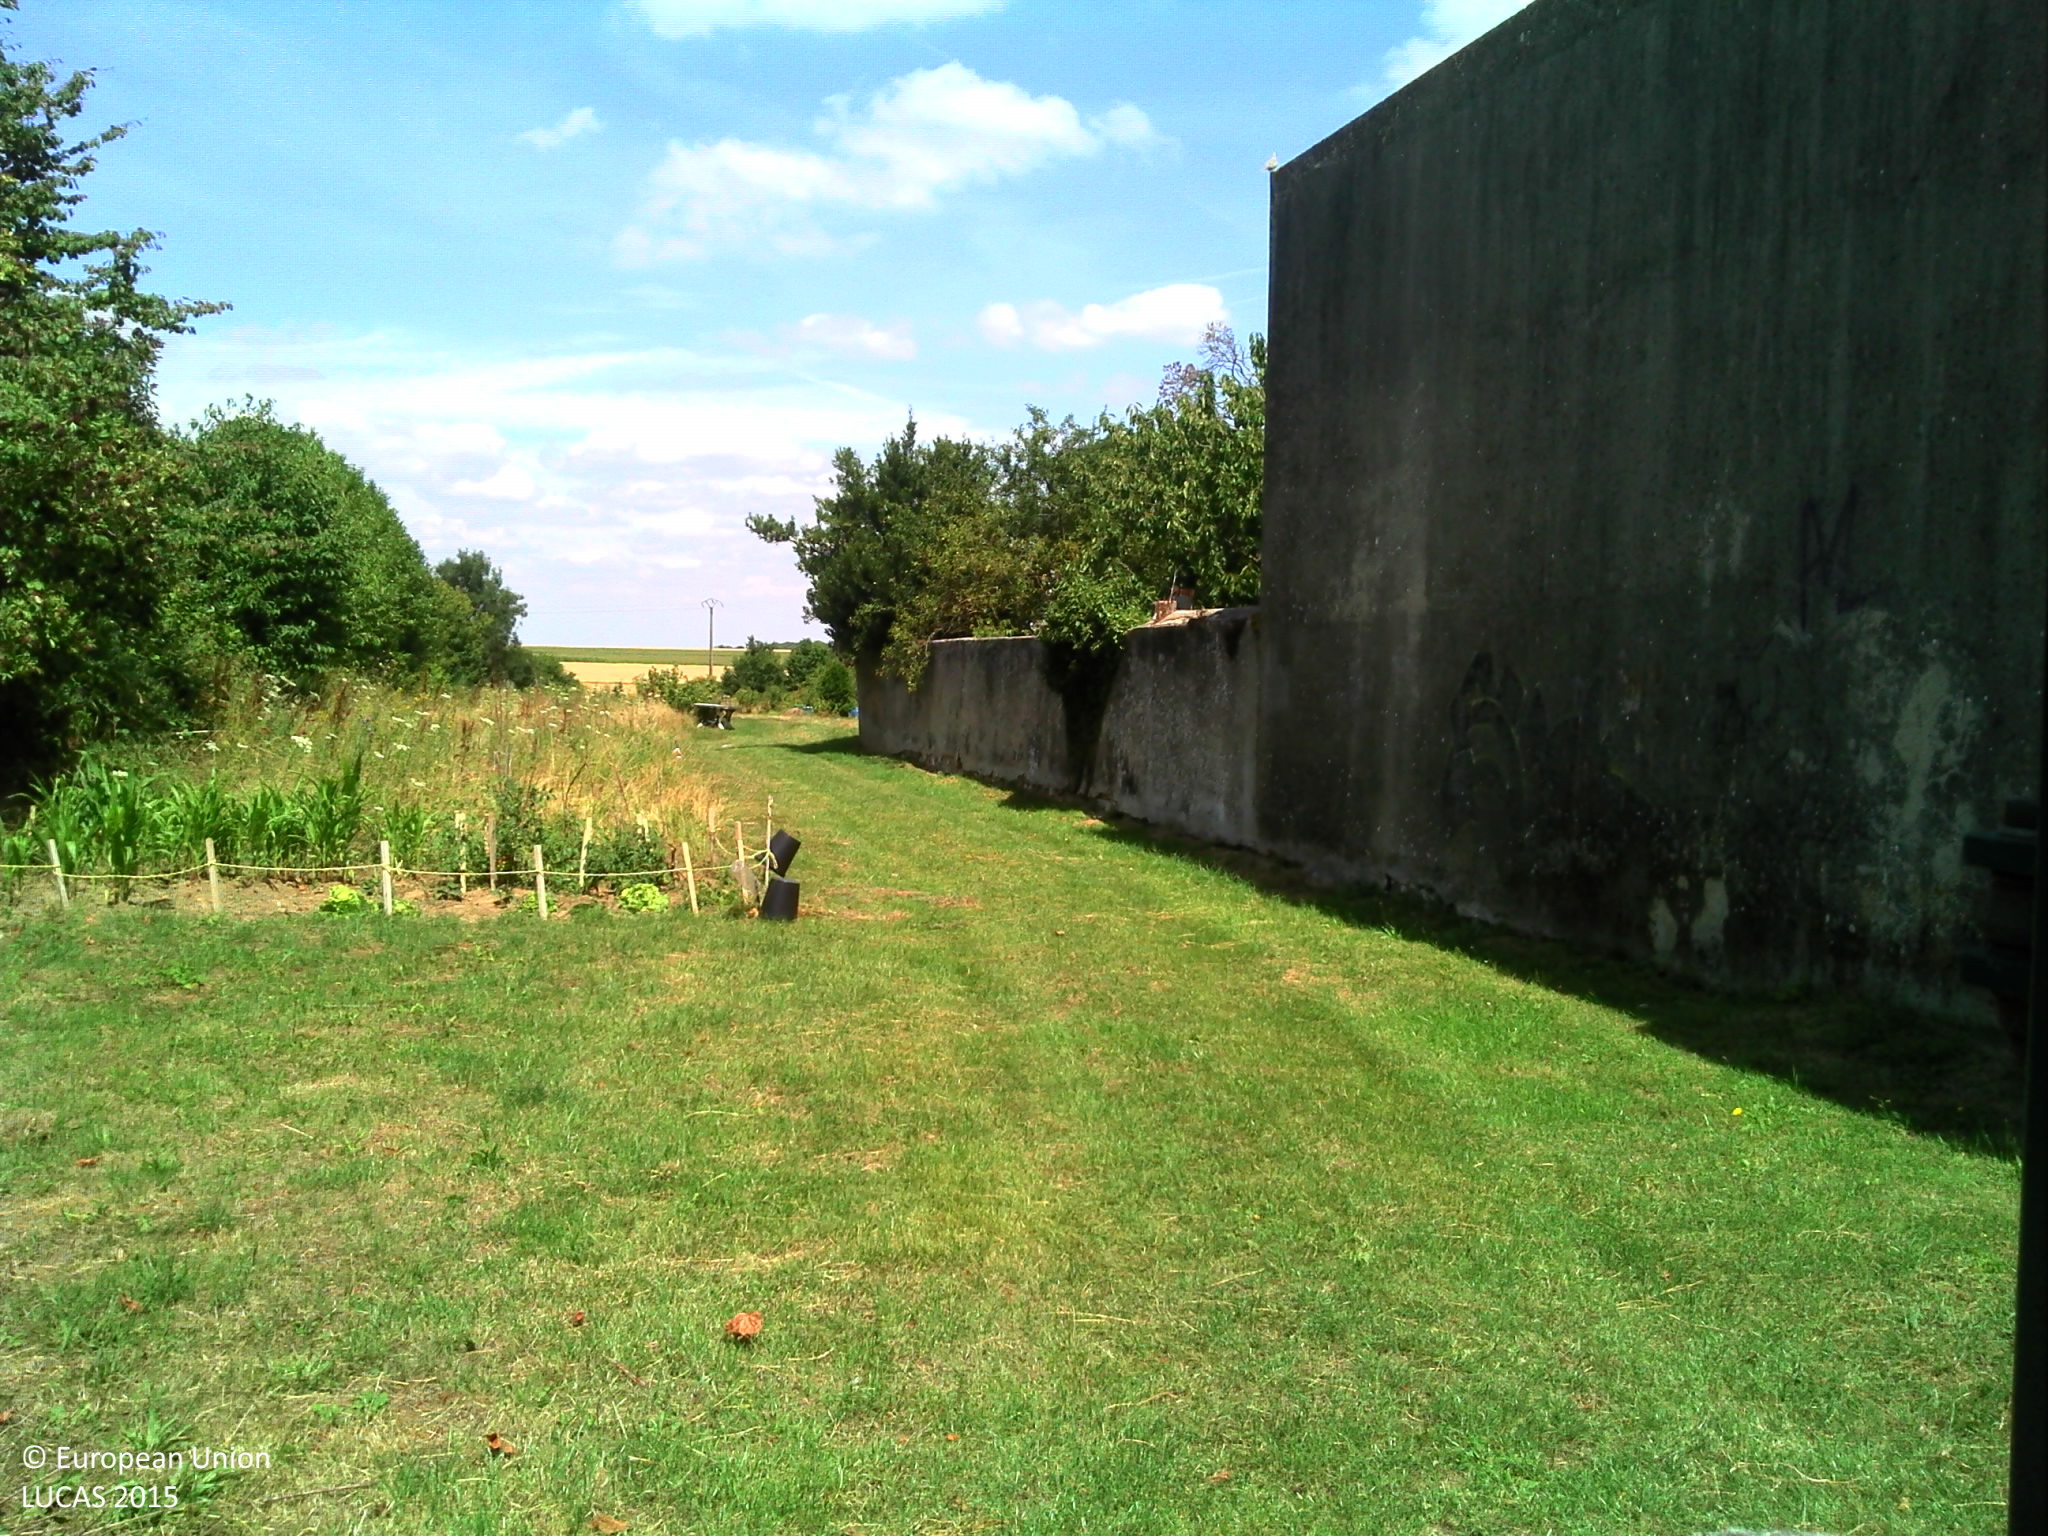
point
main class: Woodland
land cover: Broadleaved woodland
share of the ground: > 75 %
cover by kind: broadleaved forest trees 85 %, herbaceous plants 15 %
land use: Residential
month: July
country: FR
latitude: 49.0683
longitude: 2.4738
